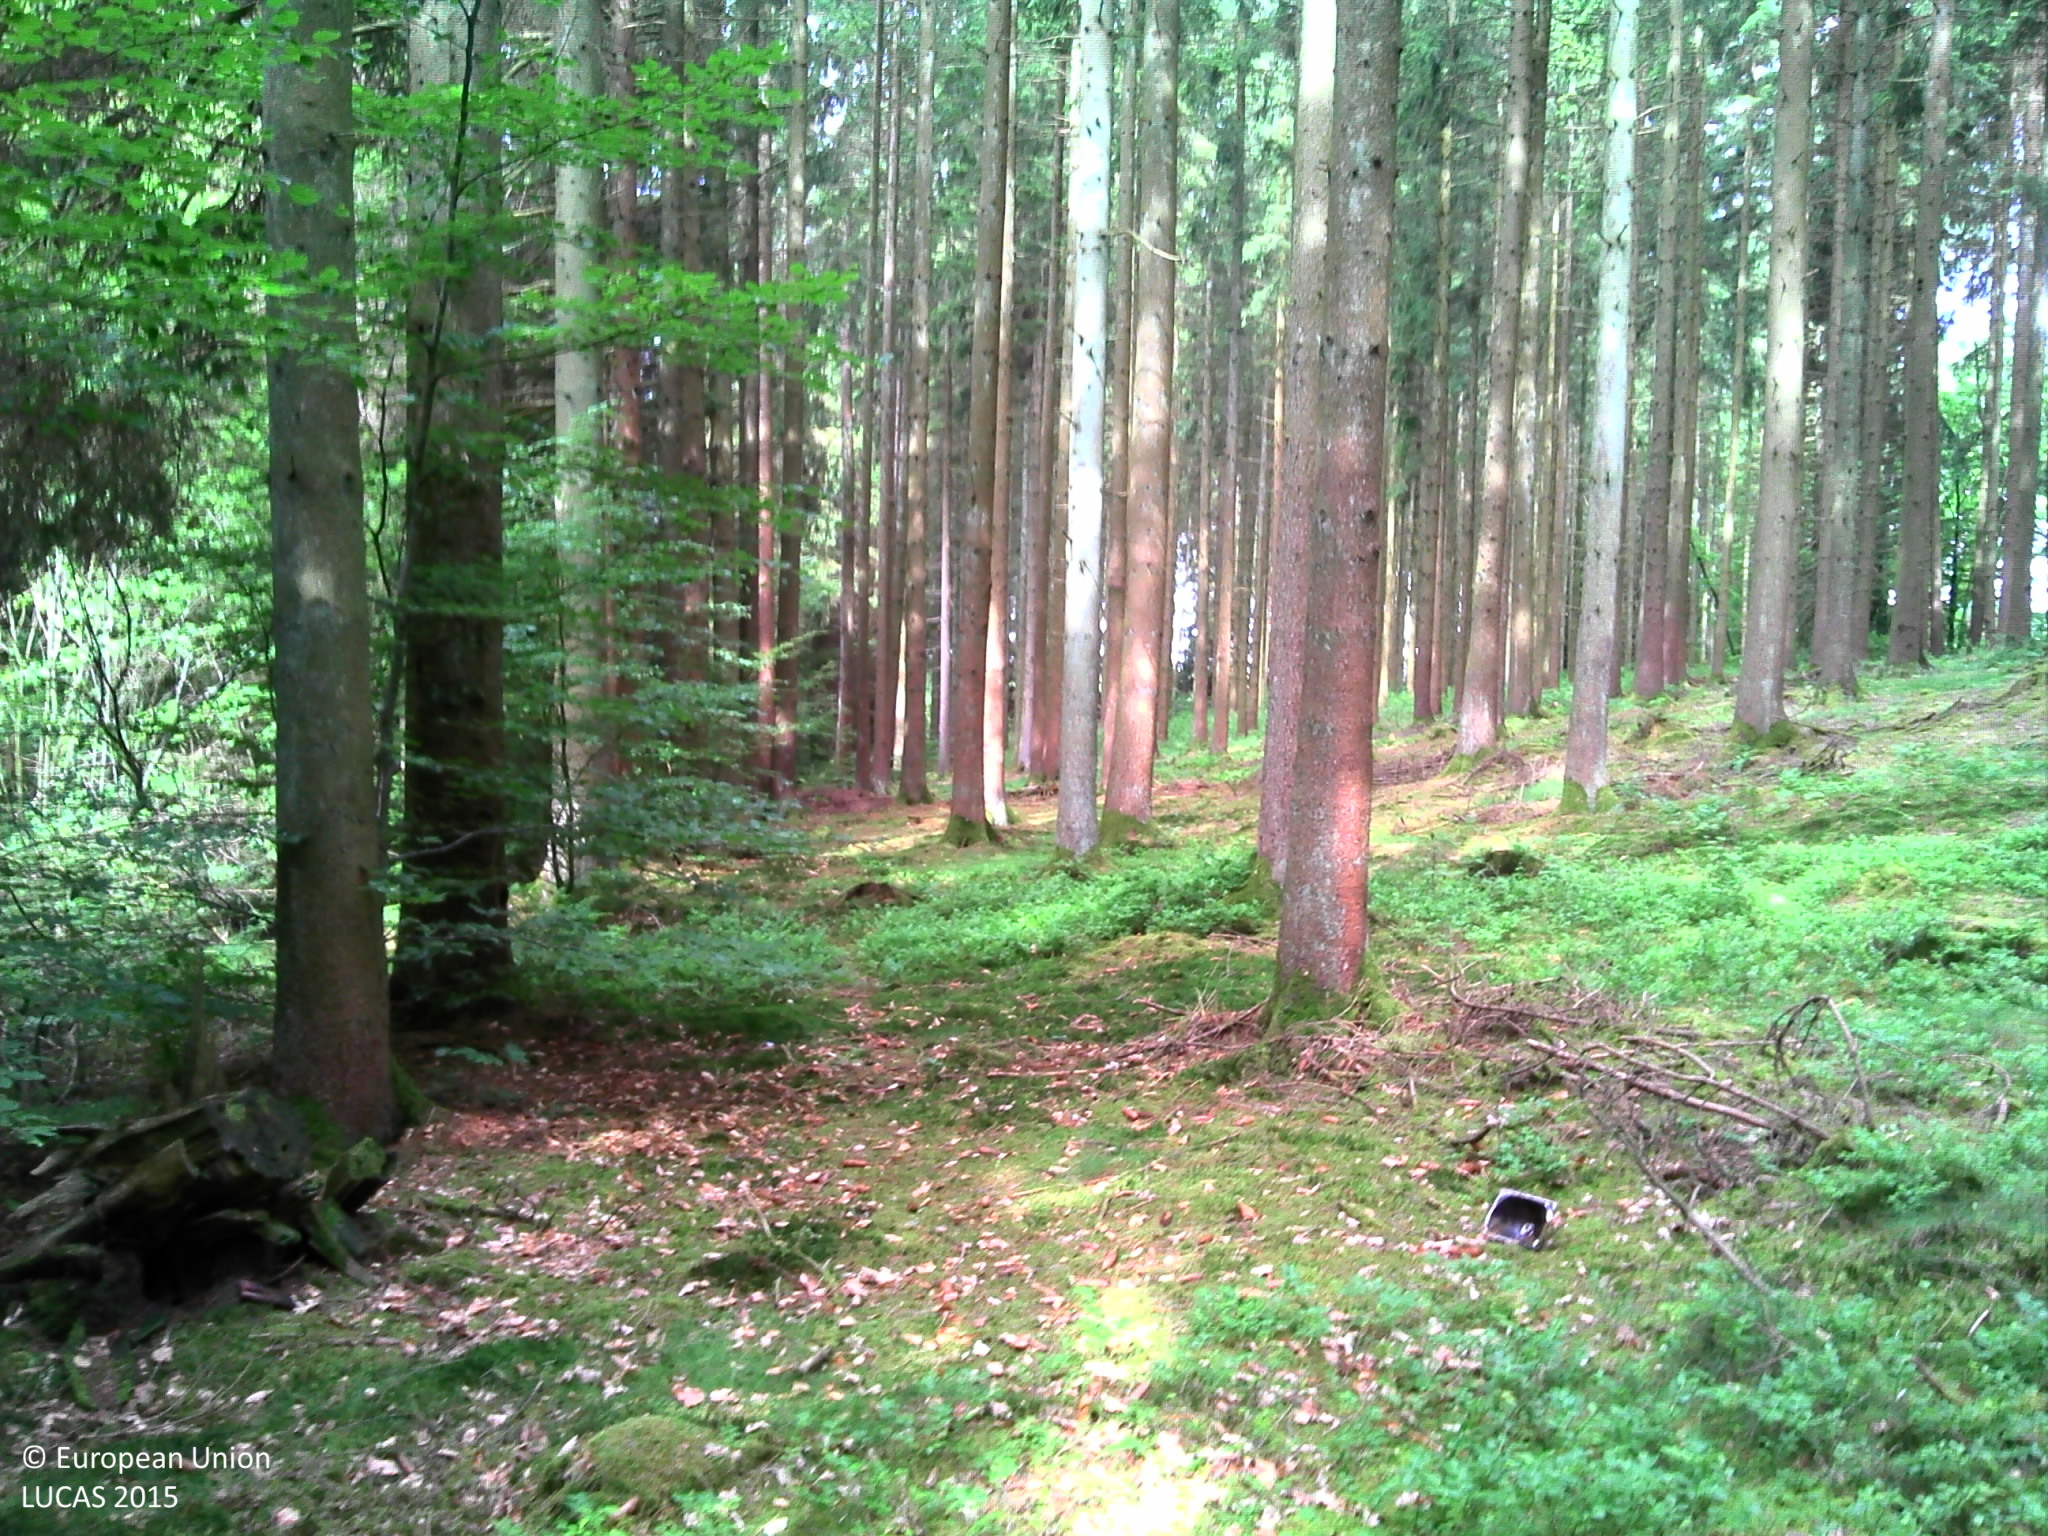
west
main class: Woodland
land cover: Spruce dominated coniferous woodland
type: alpine coniferous forest
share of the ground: > 75 %
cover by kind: coniferous forest trees 80 %, herbaceous plants 10 %, lichens and mosses 10 %
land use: Forestry
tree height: > 5 m
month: June
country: BE
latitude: 49.9254
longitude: 5.3037
